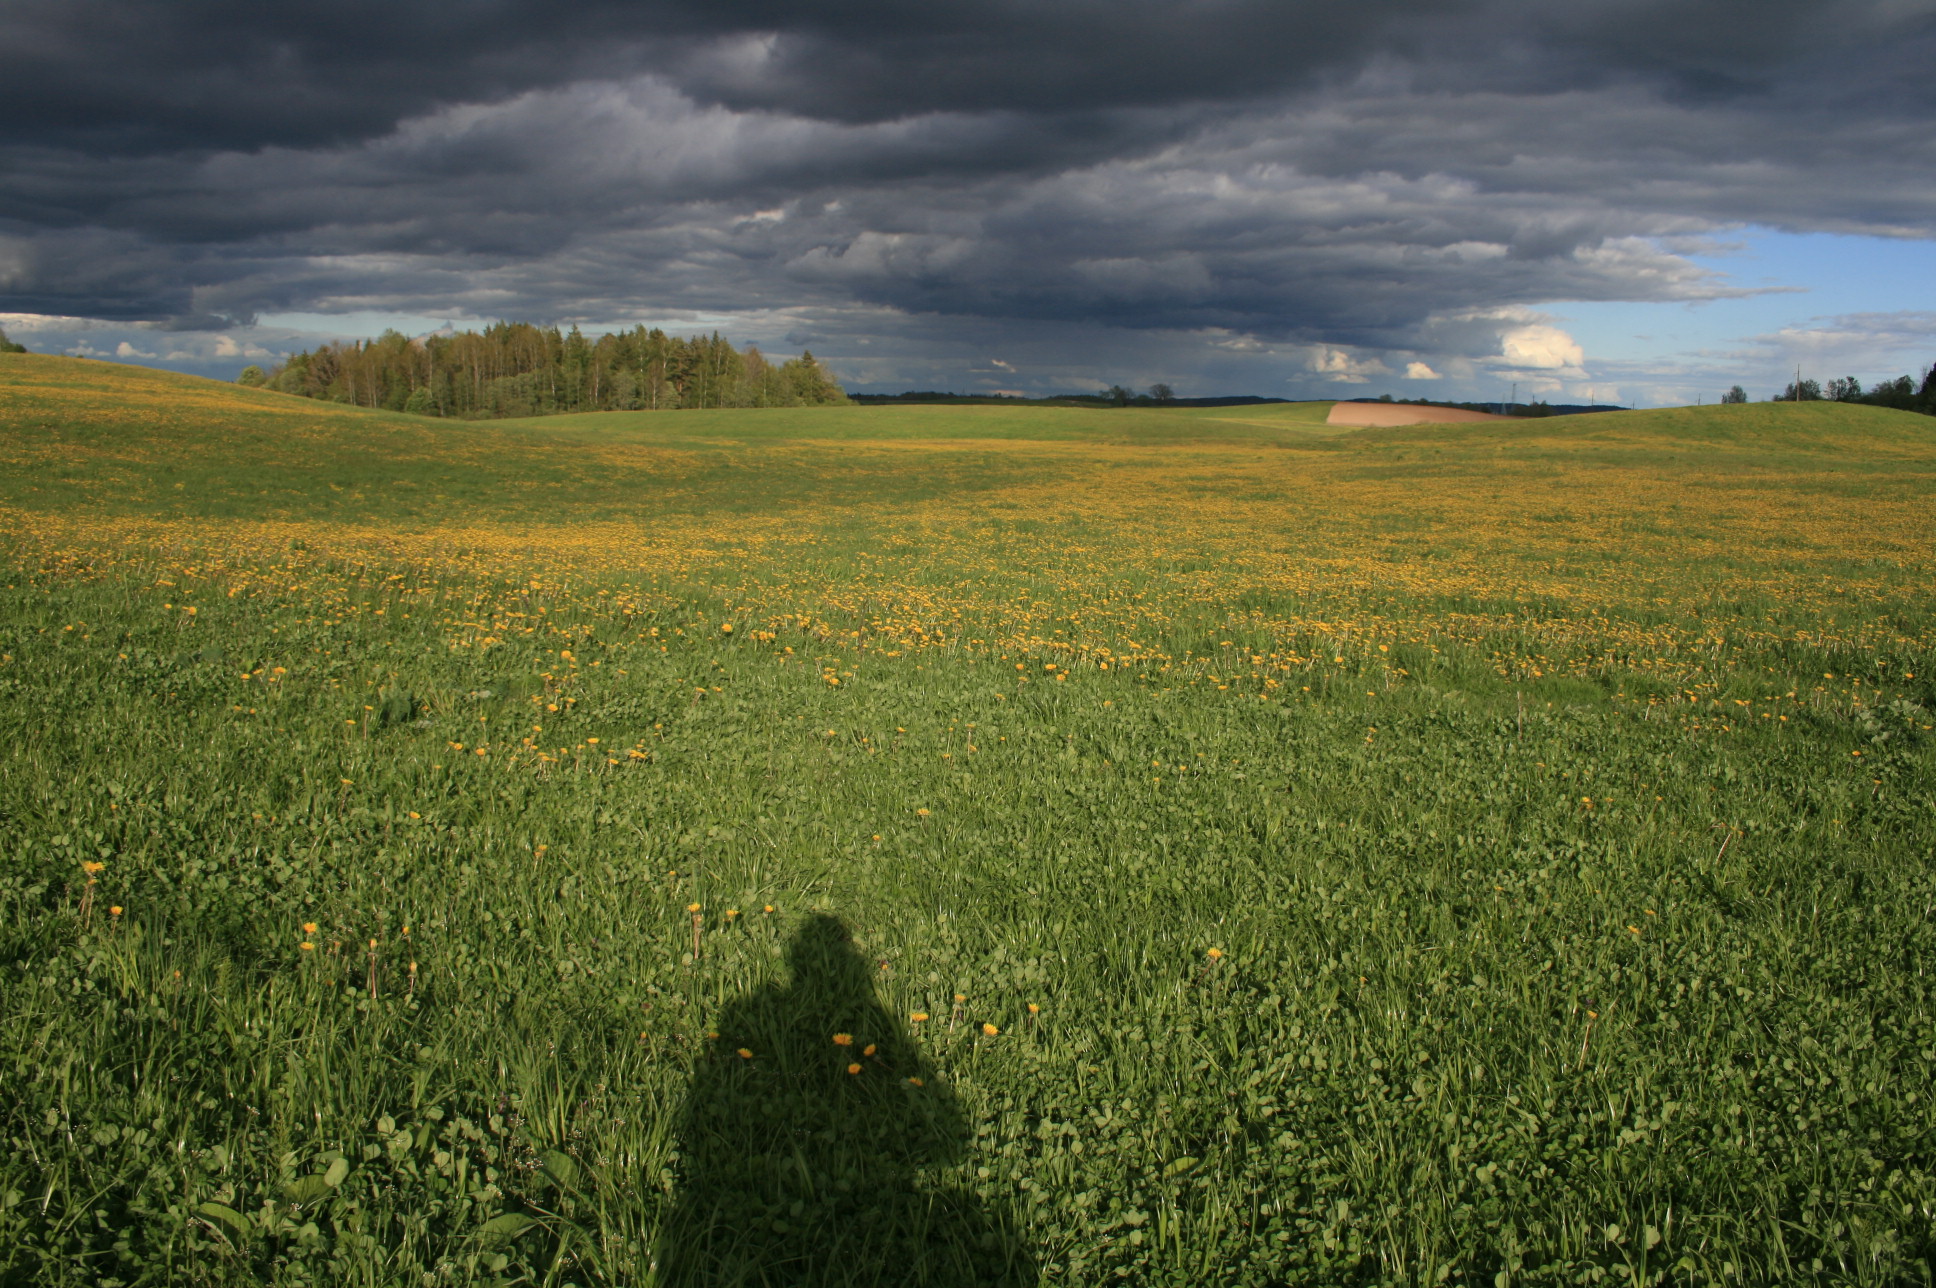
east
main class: Grassland
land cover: Grassland without tree/shrub cover
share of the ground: > 75 %
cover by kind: herbaceous plants 100 %
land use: Agriculture (excluding fallow land and kitchen gardens)
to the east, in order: Grassland without tree/shrub cover
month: May
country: LT
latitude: 56.0576
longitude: 22.0150
